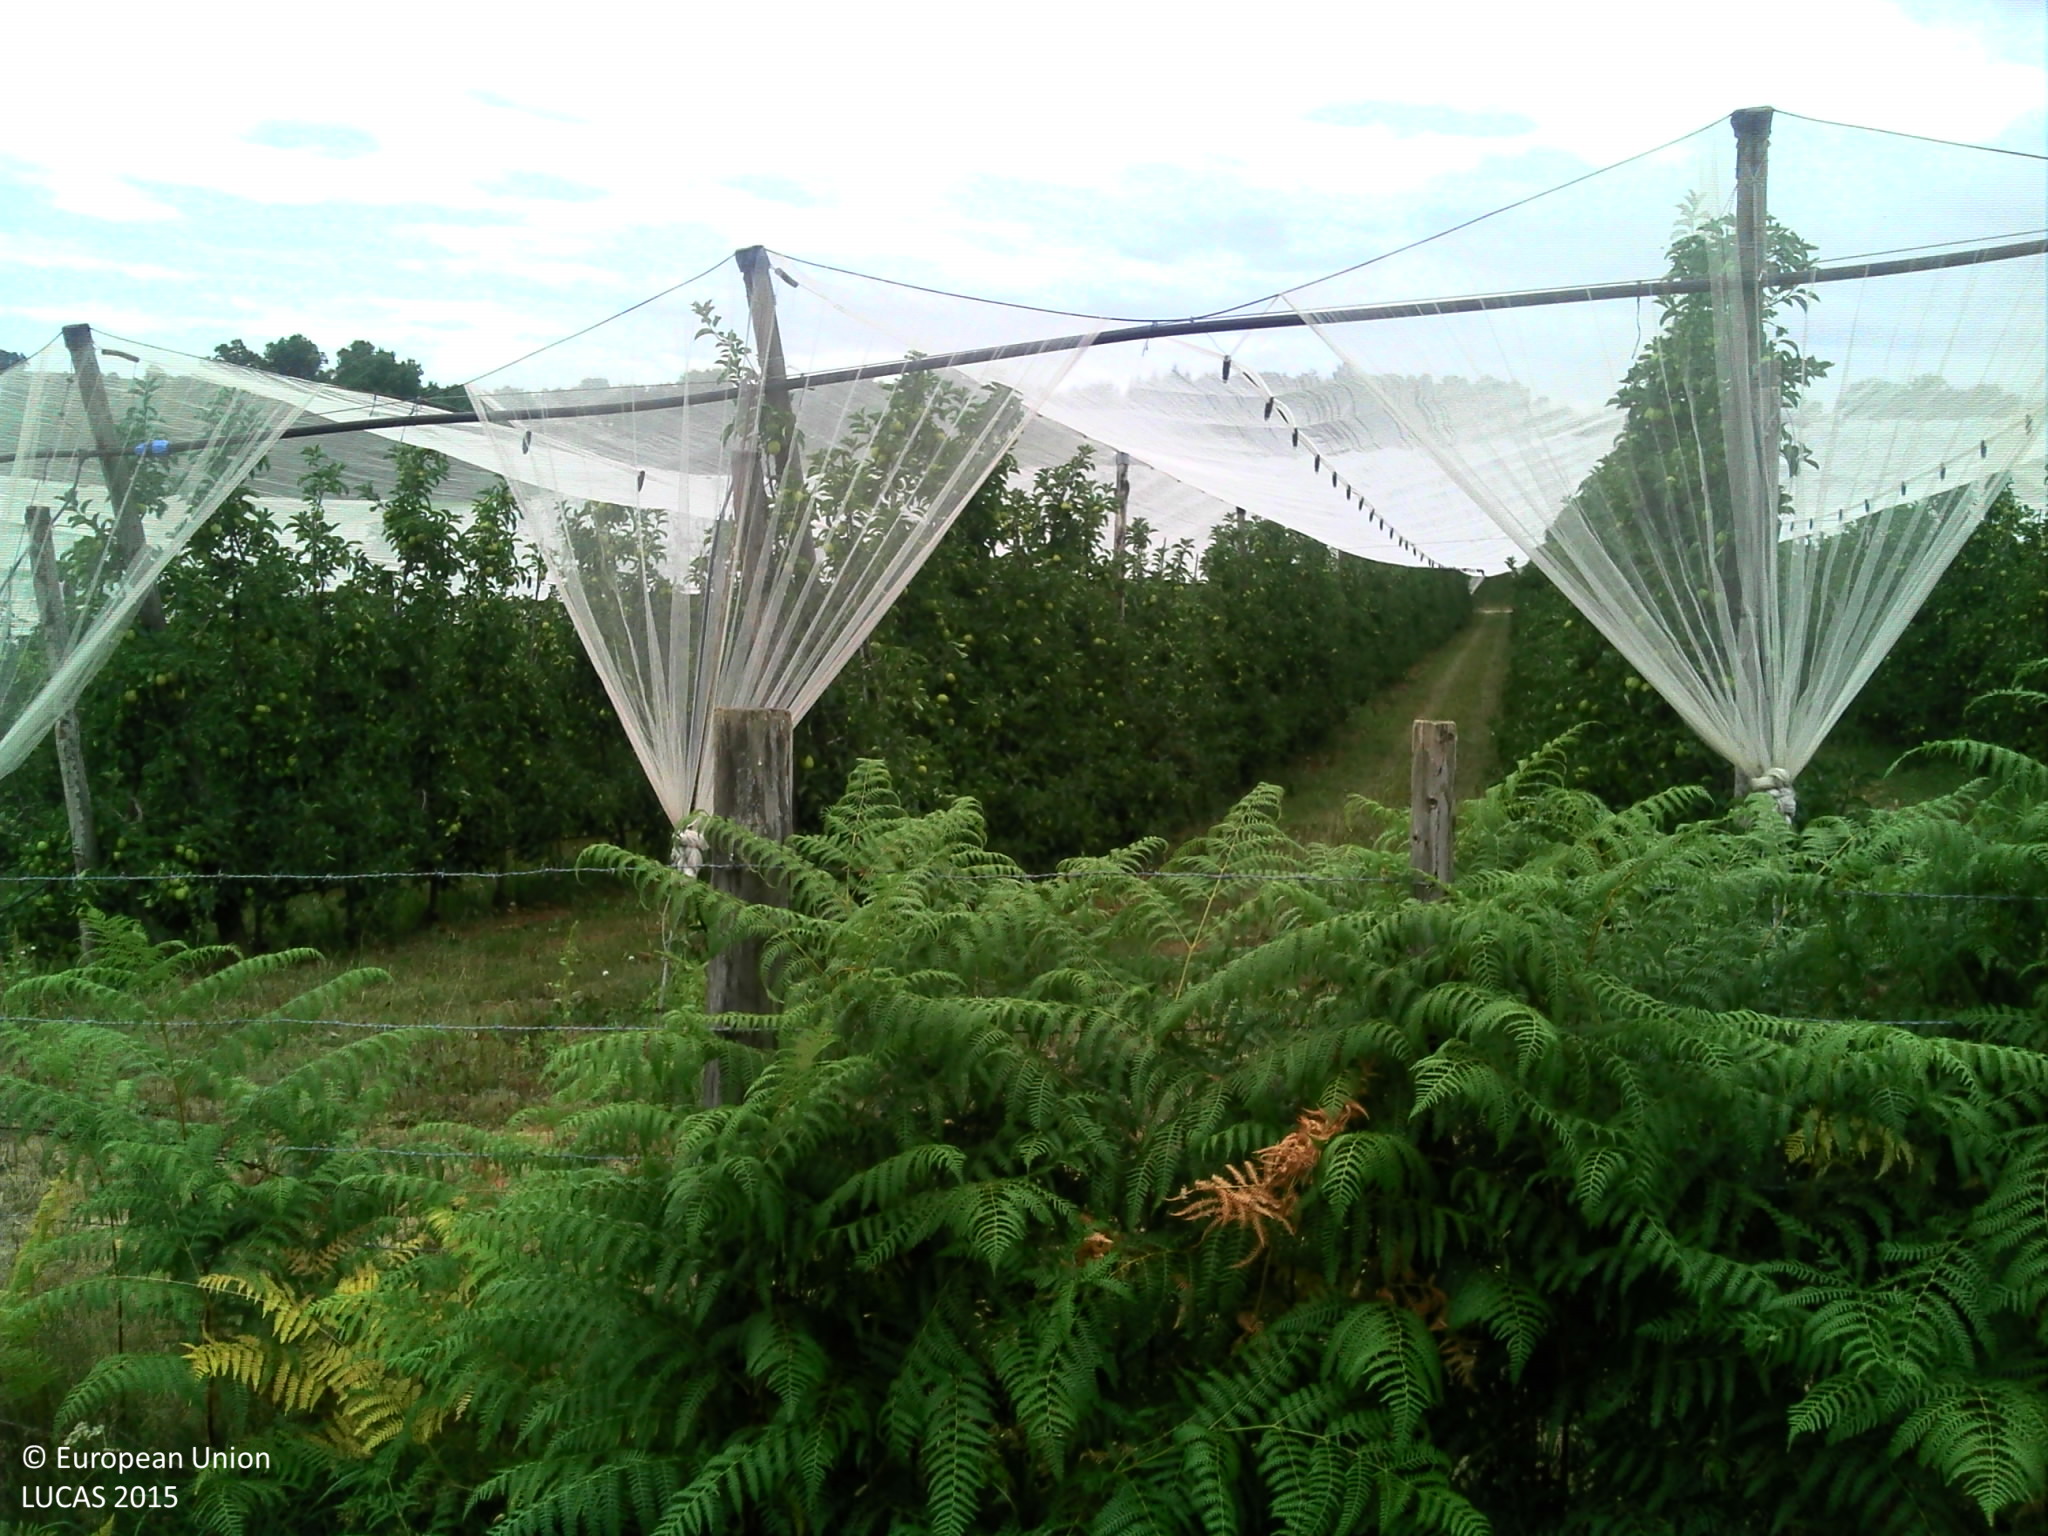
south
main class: Grassland
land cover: Spontaneously vegetated surfaces
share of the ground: > 75 %
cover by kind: herbaceous plants 95 %, shrubs 5 %
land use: Semi-natural and natural areas not in use
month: July
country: FR
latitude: 45.3463
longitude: 1.3272
